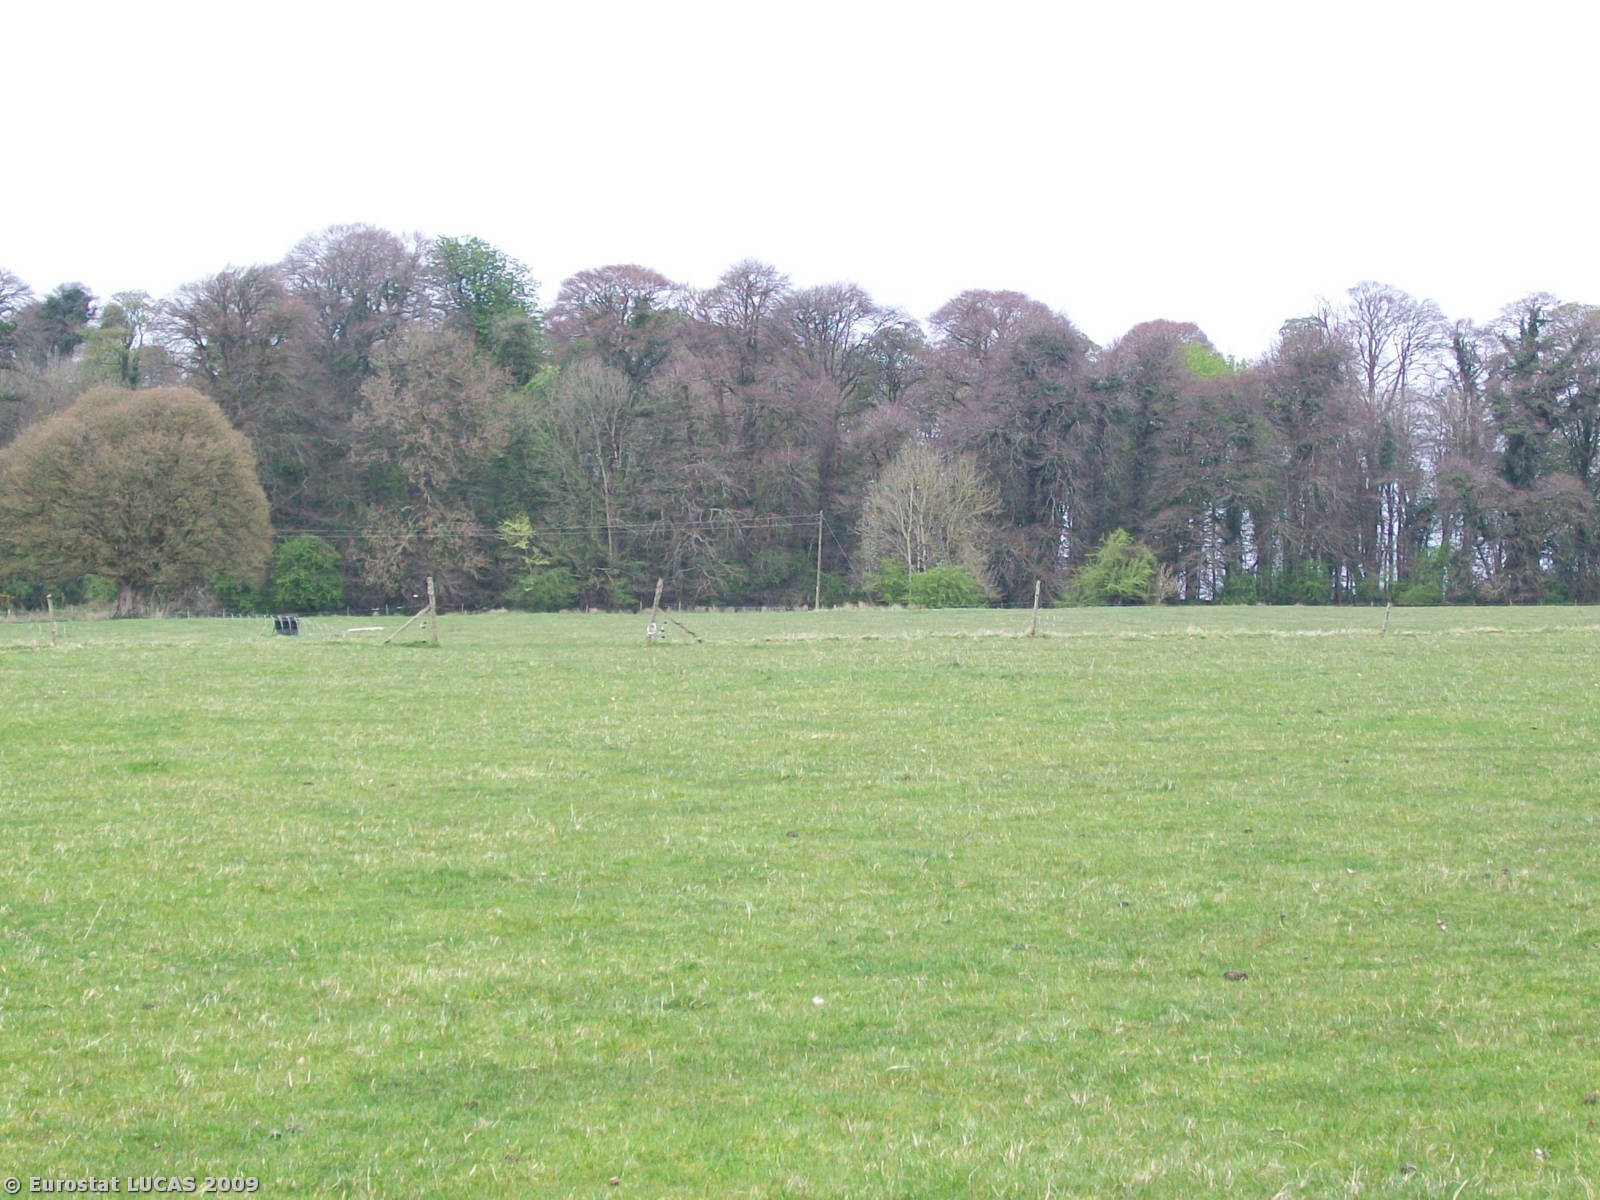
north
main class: Grassland
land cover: Grassland without tree/shrub cover
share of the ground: > 75 %
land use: Agriculture (excluding fallow land and kitchen gardens)
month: April
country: IE
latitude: 53.6185
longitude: -8.1554
